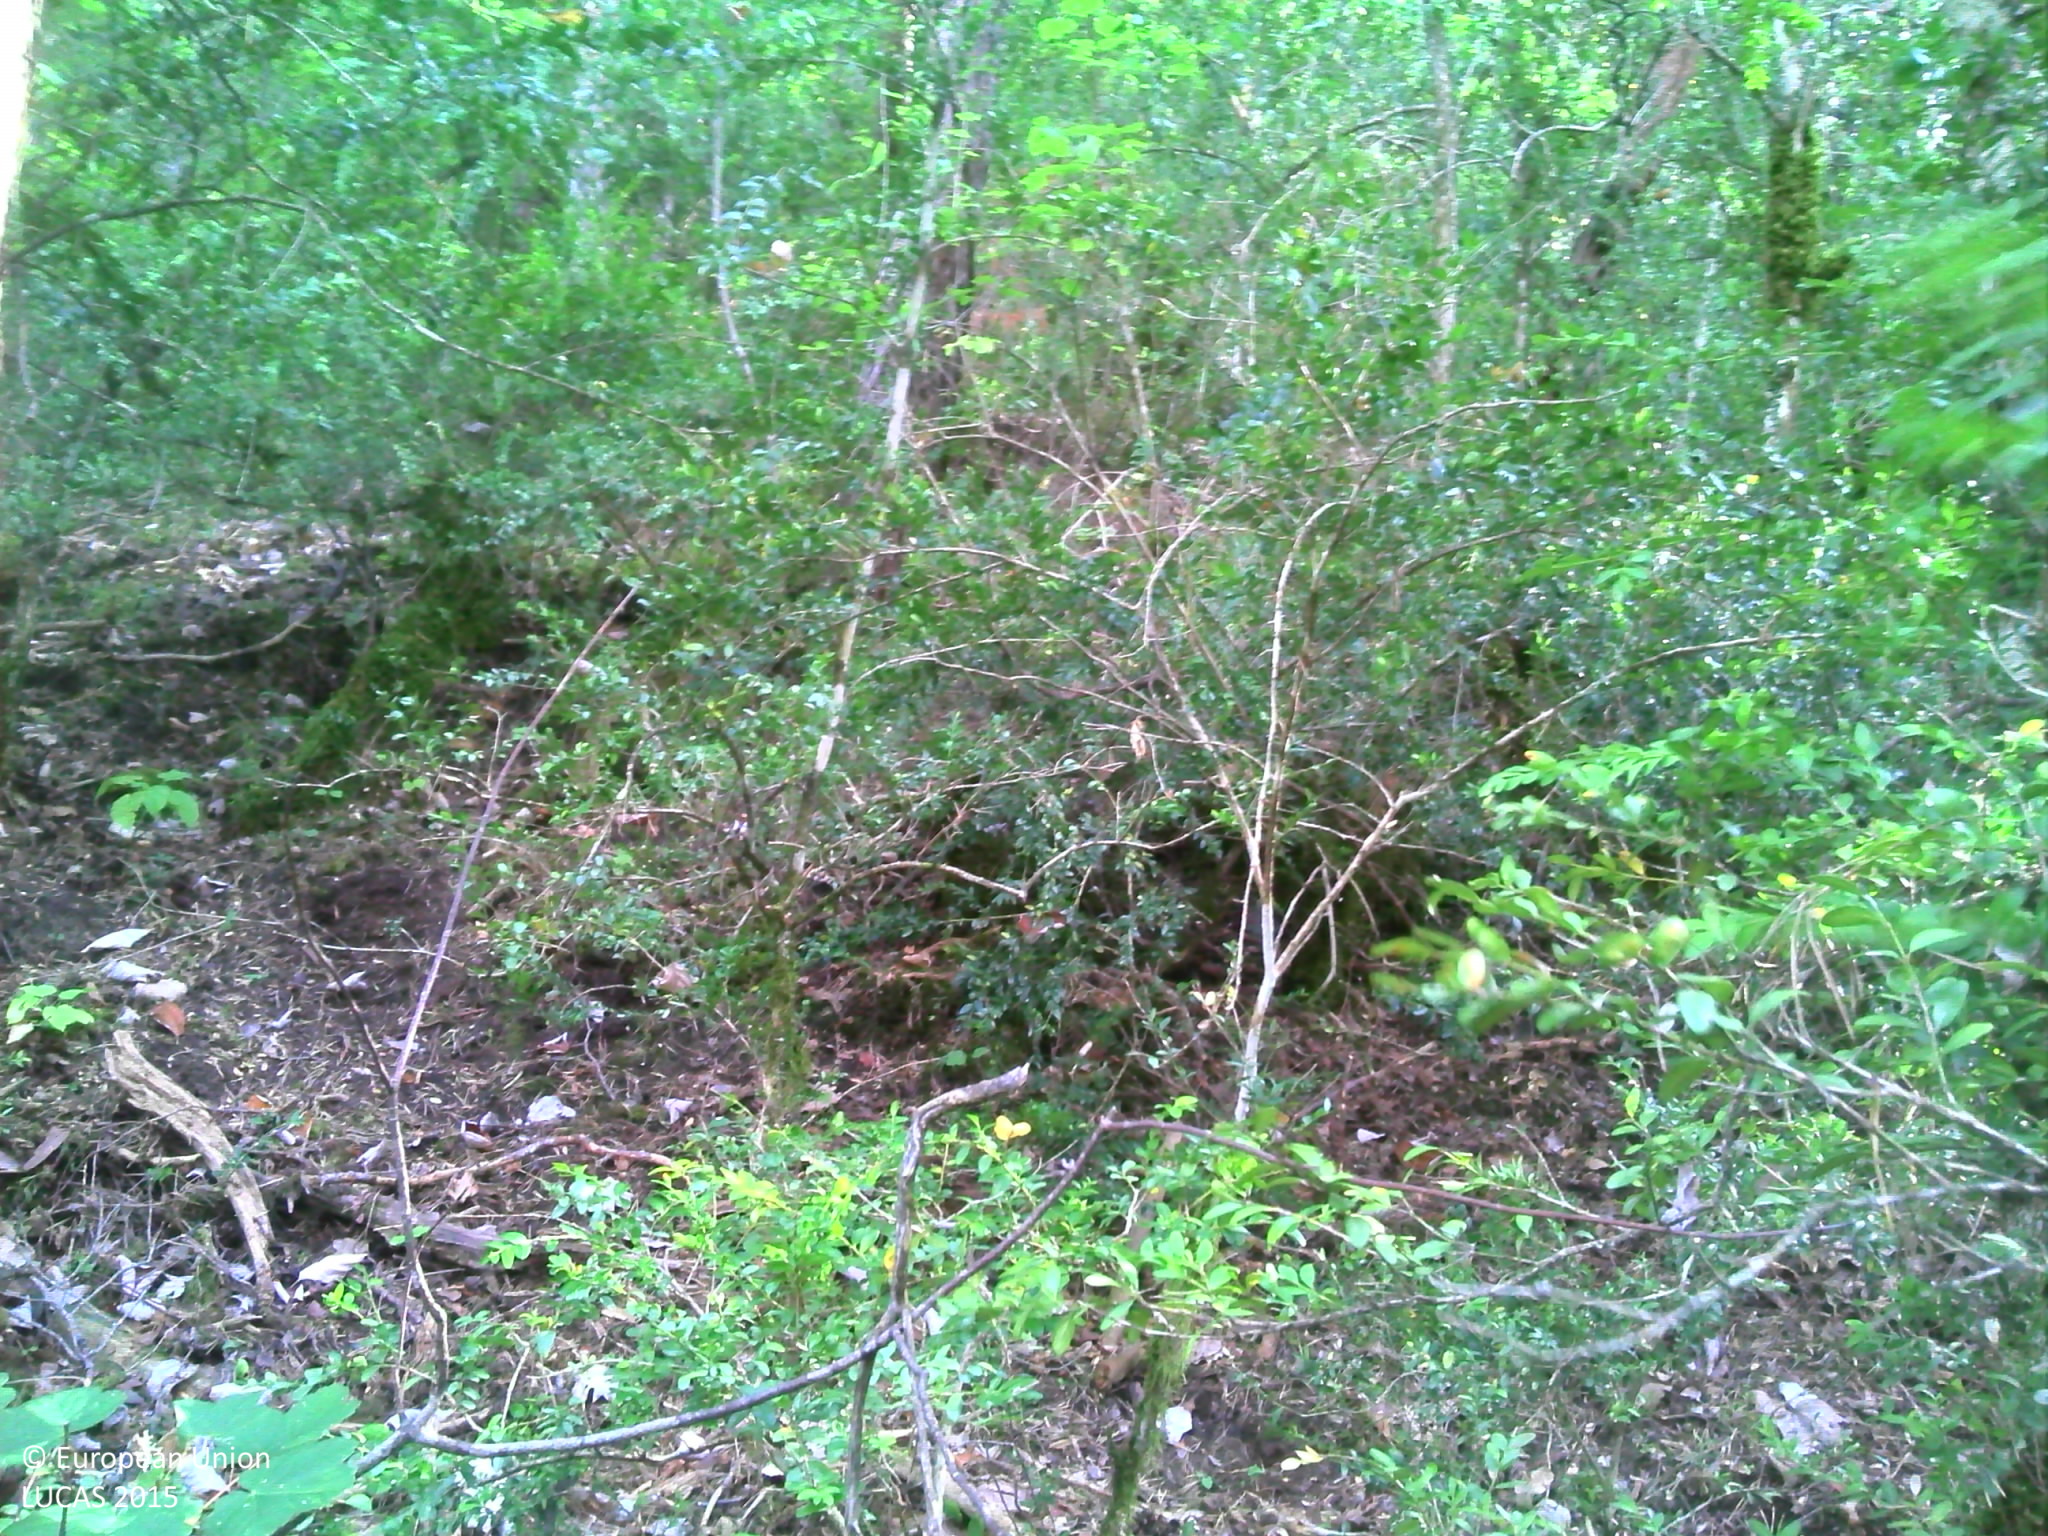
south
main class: Woodland
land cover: Pine dominated mixed woodland
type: coniferous forest of the mediterranean region
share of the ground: > 75 %
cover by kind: broadleaved forest trees 65 %, coniferous forest trees 25 %, herbaceous plants 10 %
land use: Forestry
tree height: > 5 m
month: September
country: FR
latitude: 44.6865
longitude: 5.5022
